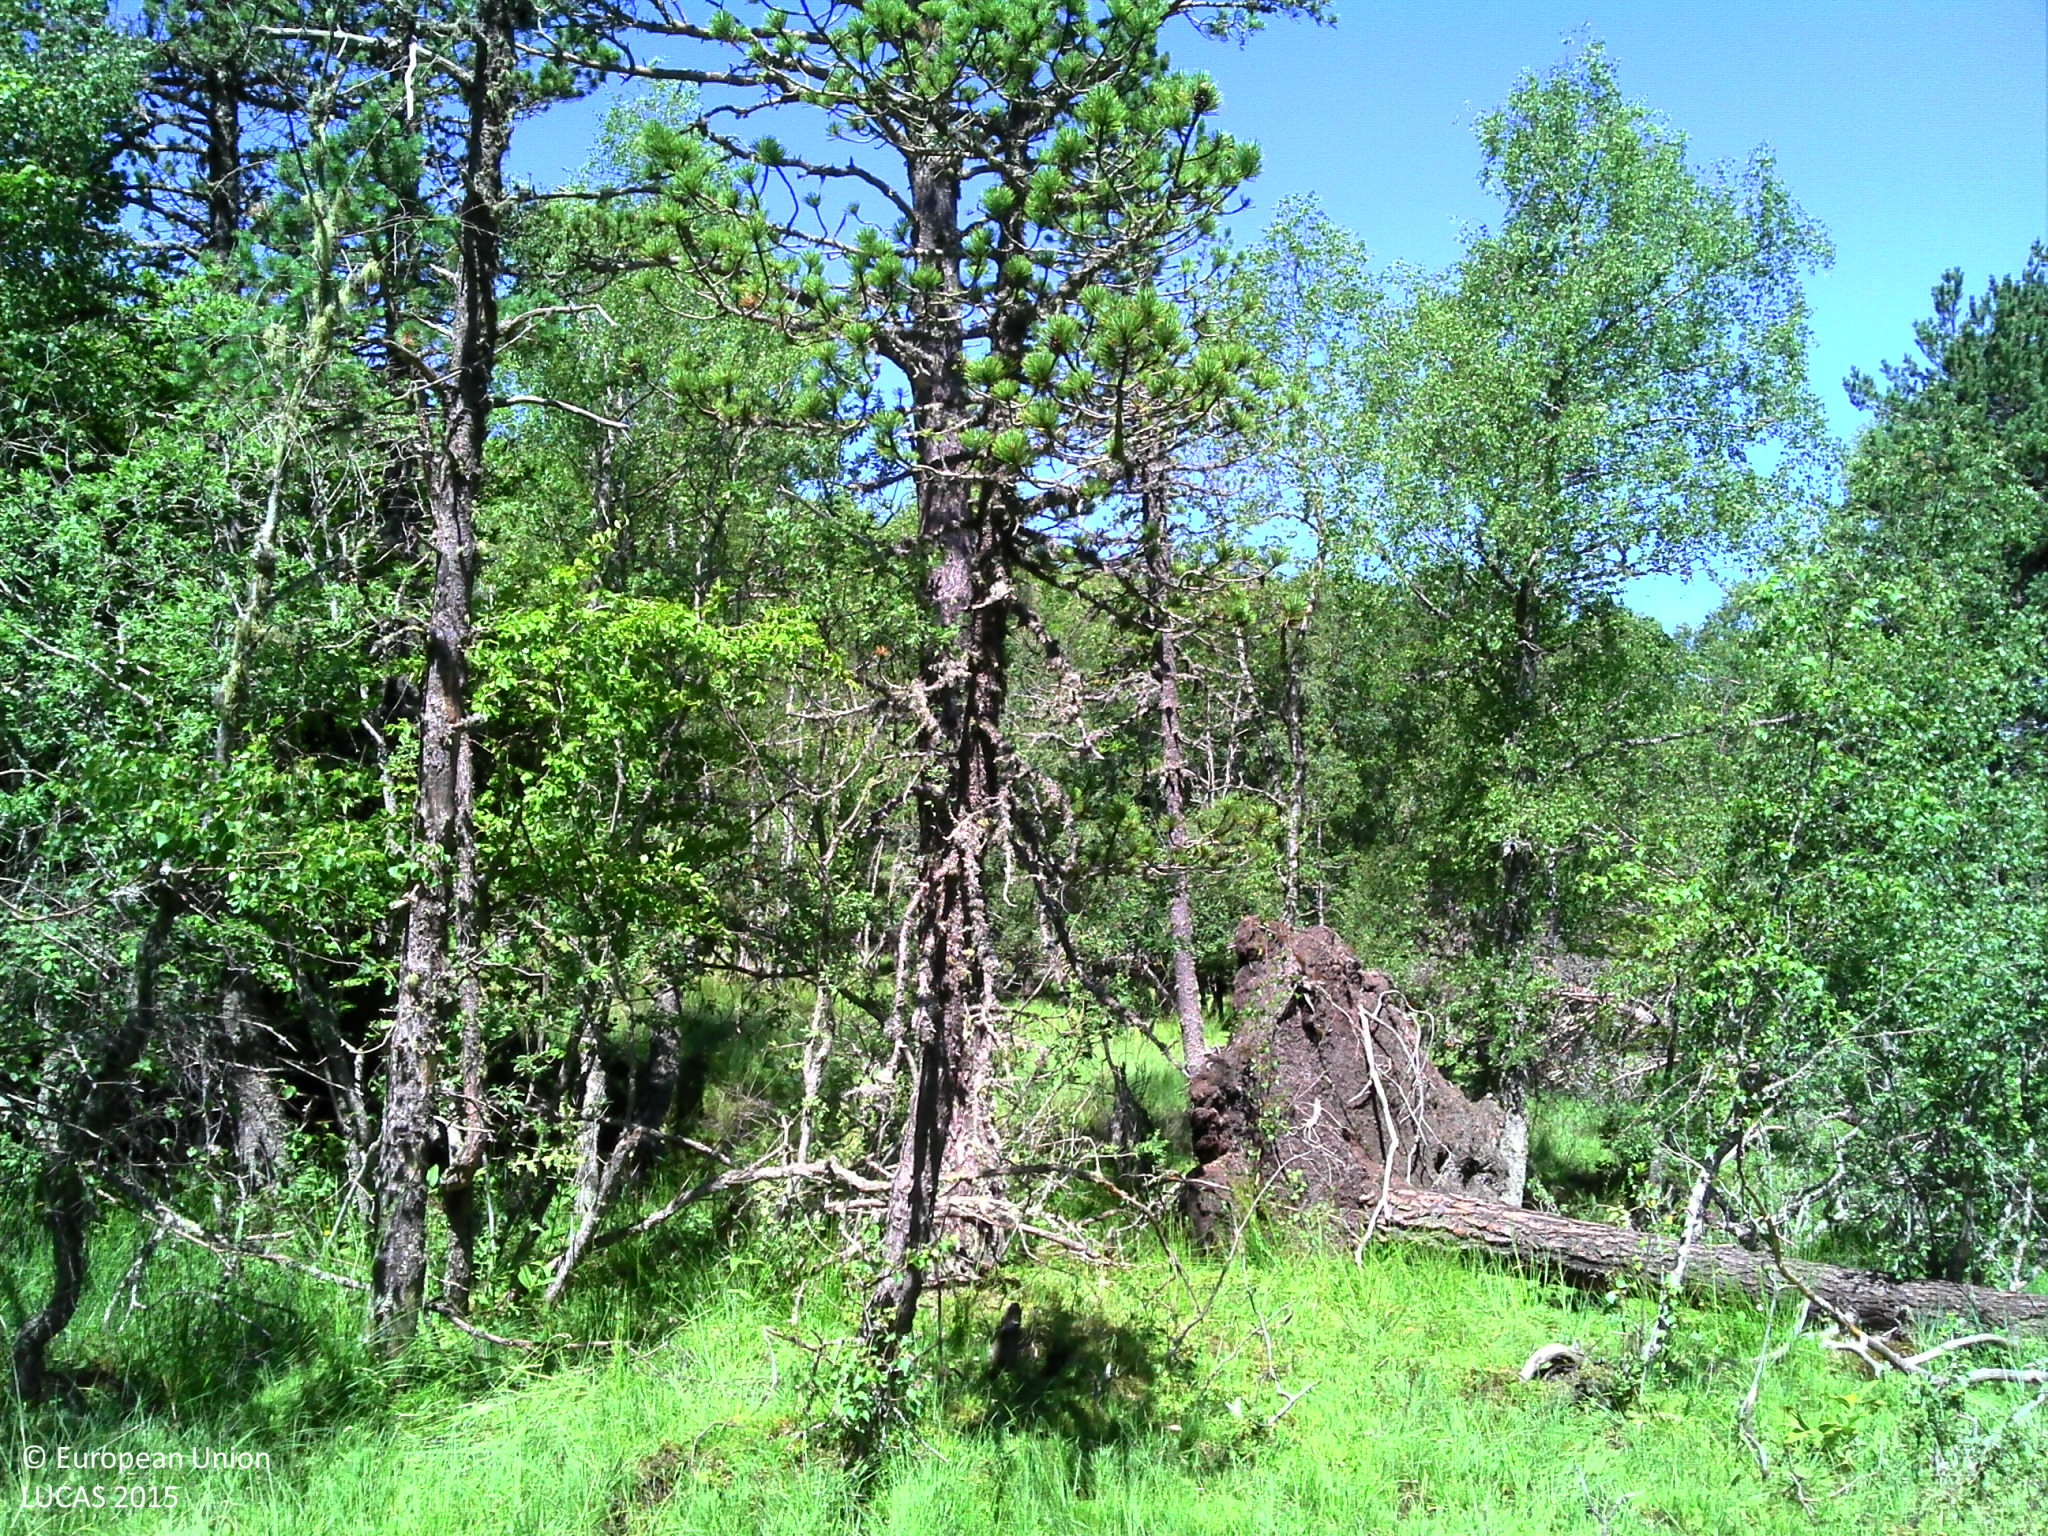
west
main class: Woodland
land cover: Pine dominated mixed woodland
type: hemiboreal forest and nemoral coniferous forest and mixed broadleaved-coniferous forest
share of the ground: > 75 %
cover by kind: broadleaved forest trees 40 %, coniferous forest trees 35 %, herbaceous plants 20 %
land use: Forestry
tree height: > 5 m
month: July
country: FR
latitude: 42.6728
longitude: 2.1155
